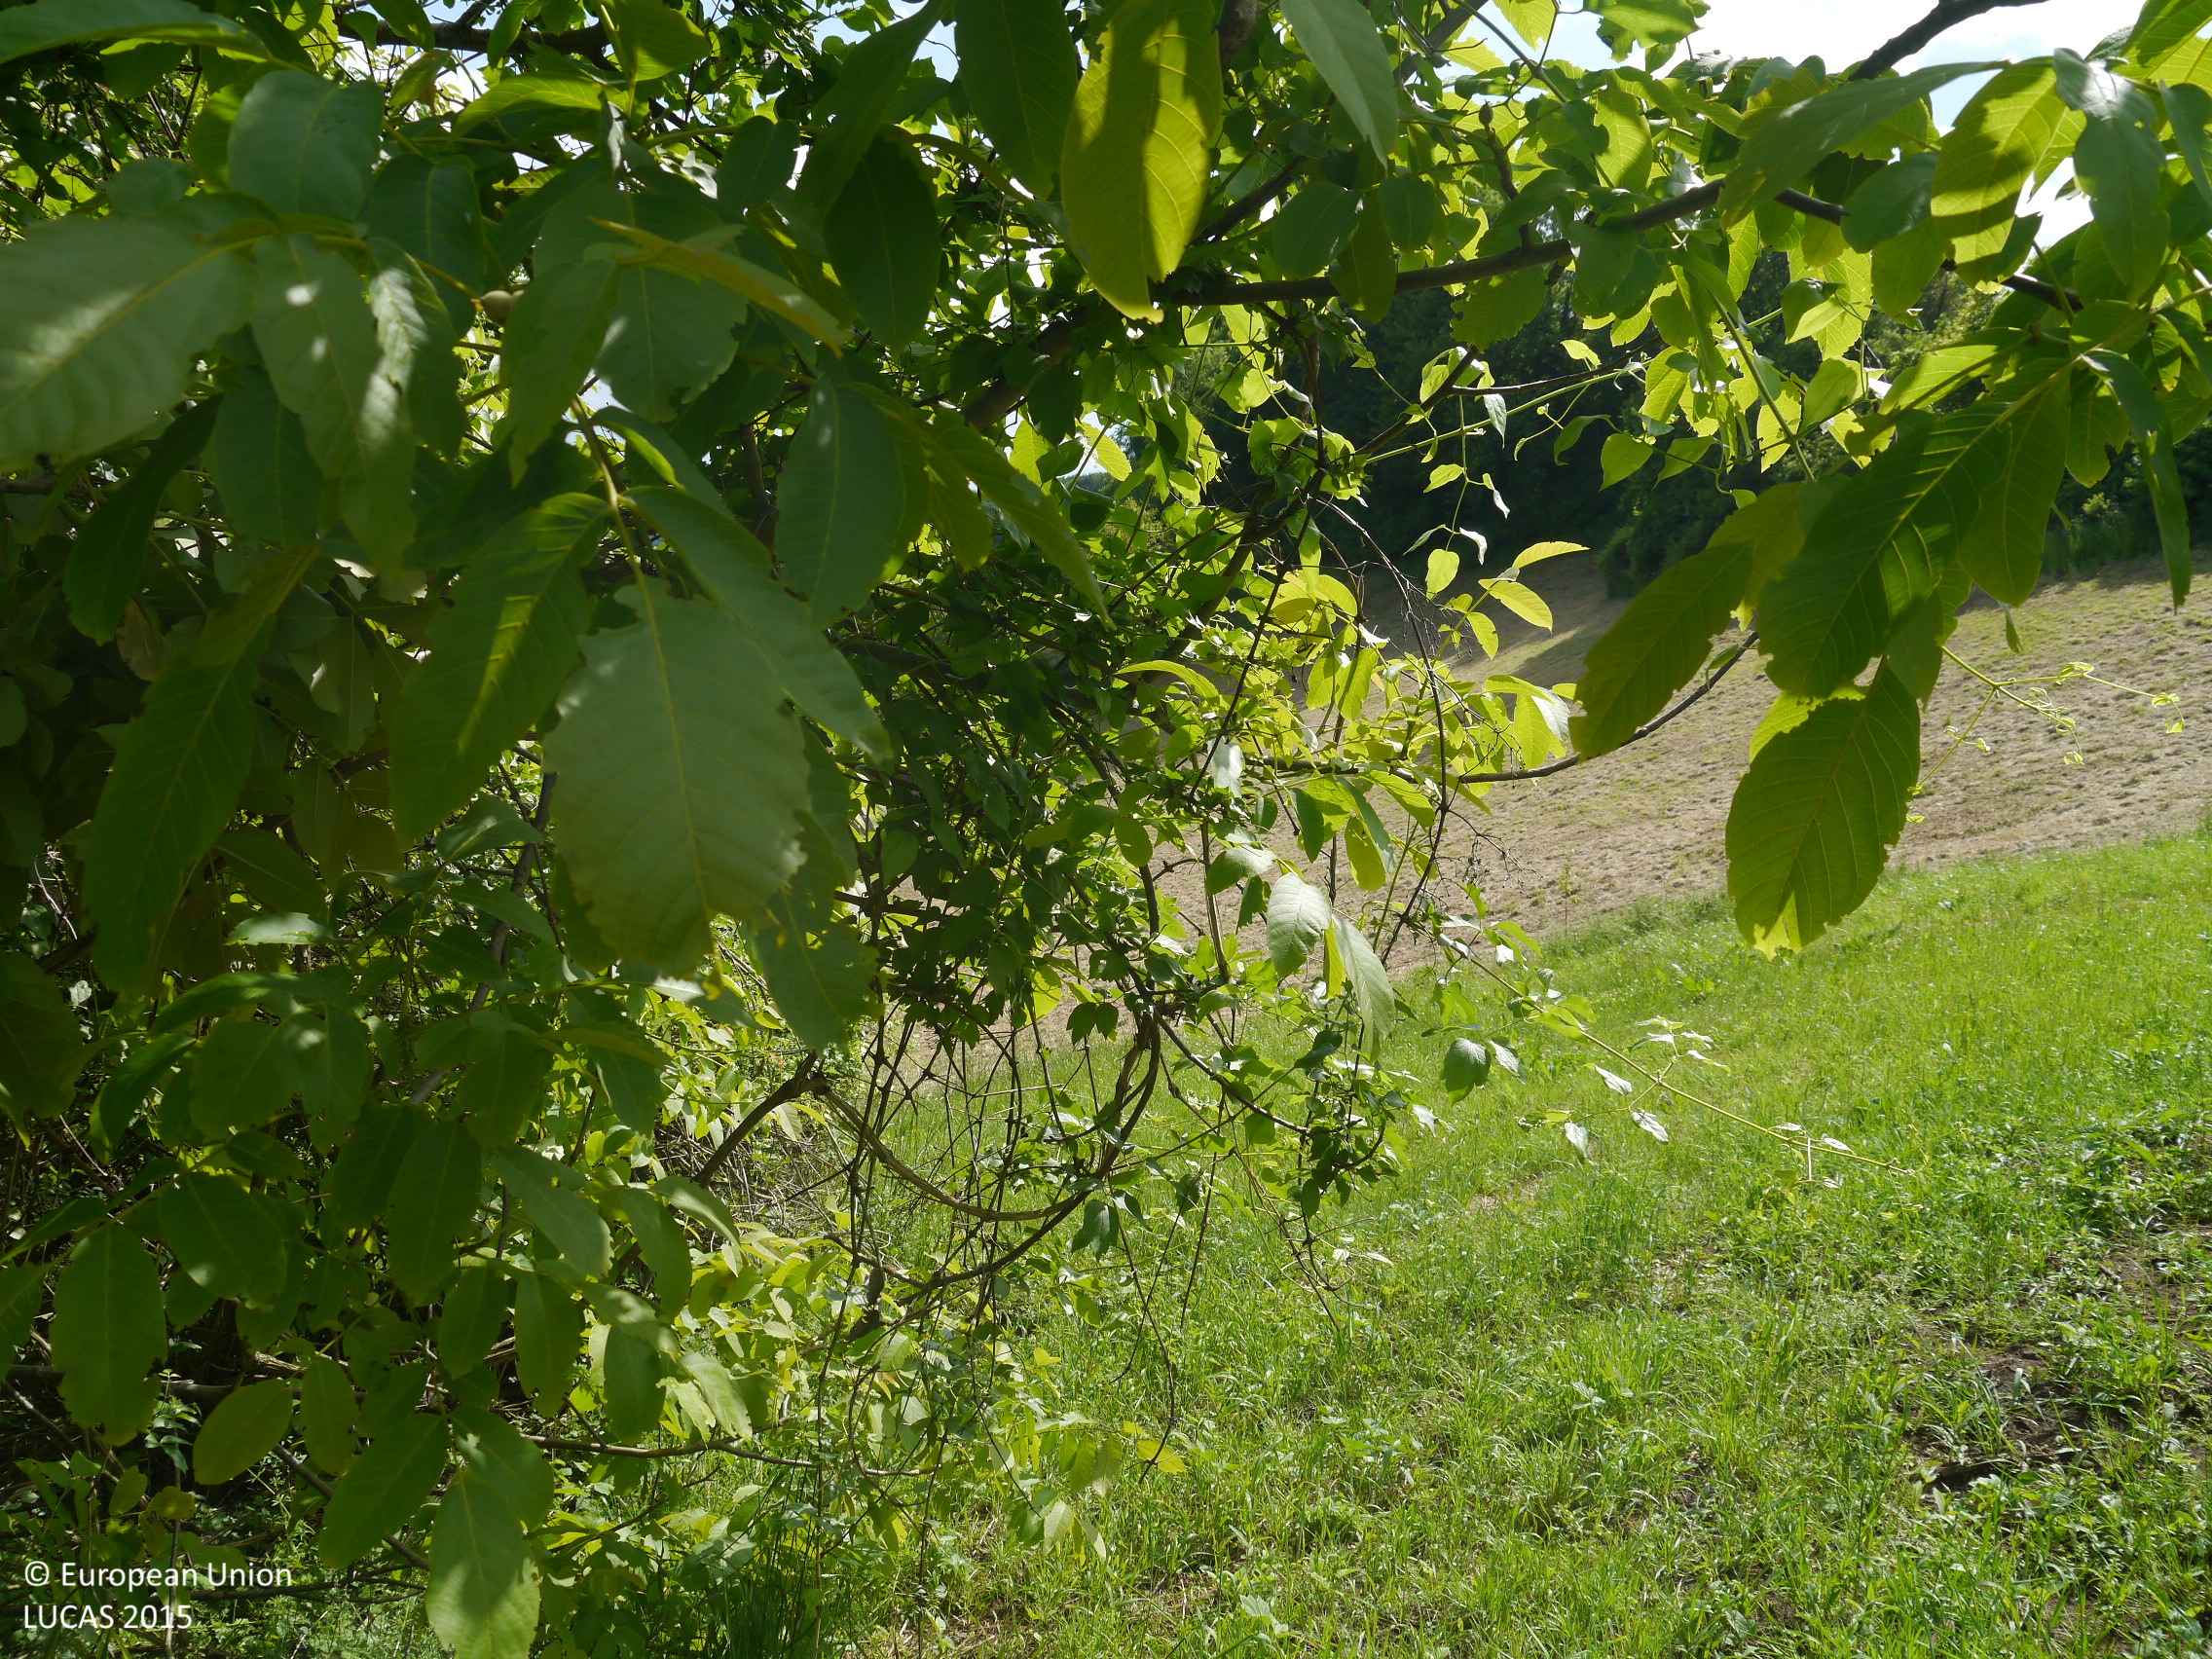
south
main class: Grassland
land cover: Grassland without tree/shrub cover
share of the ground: > 75 %
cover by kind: herbaceous plants 100 %
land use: Agriculture (excluding fallow land and kitchen gardens)
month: May
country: AT
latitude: 46.8735
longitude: 15.9177
